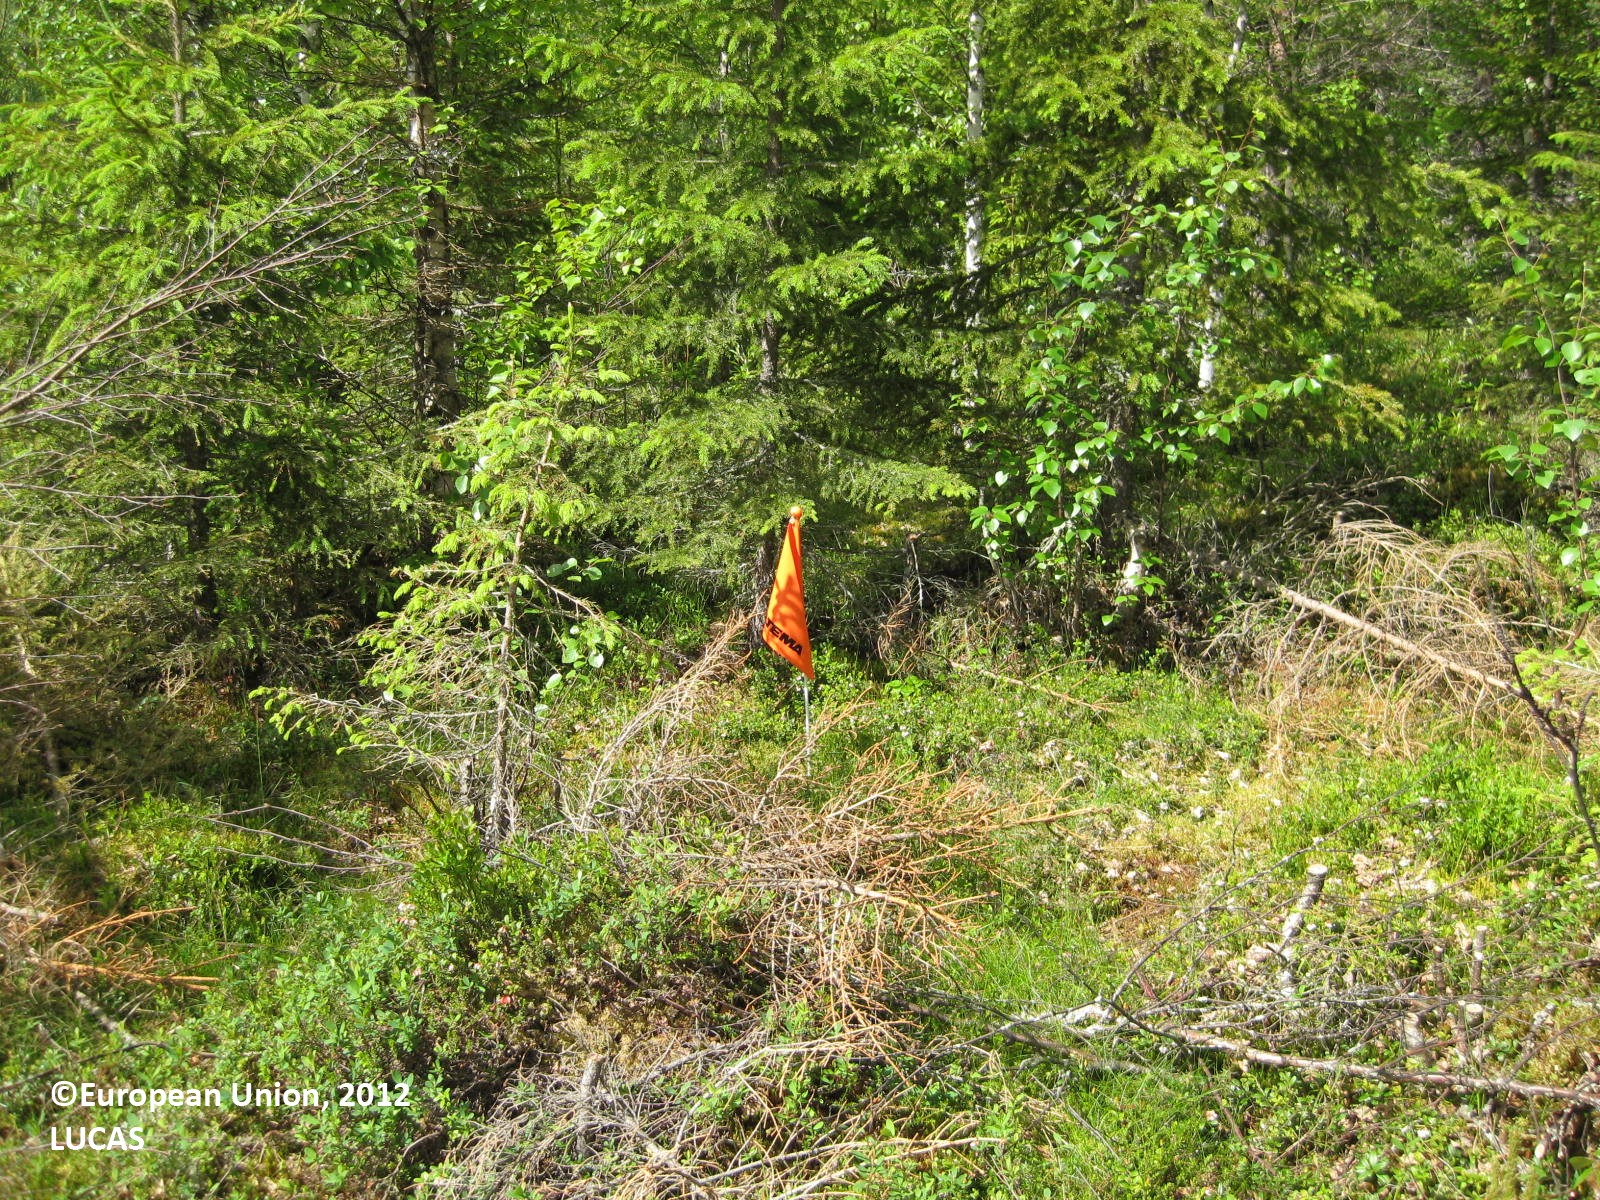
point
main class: Woodland
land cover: Spruce dominated mixed woodland
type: boreal forest
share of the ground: 50 - 75 %
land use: Forestry
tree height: > 5 m
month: June
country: FI
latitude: 65.3523
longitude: 28.3165
